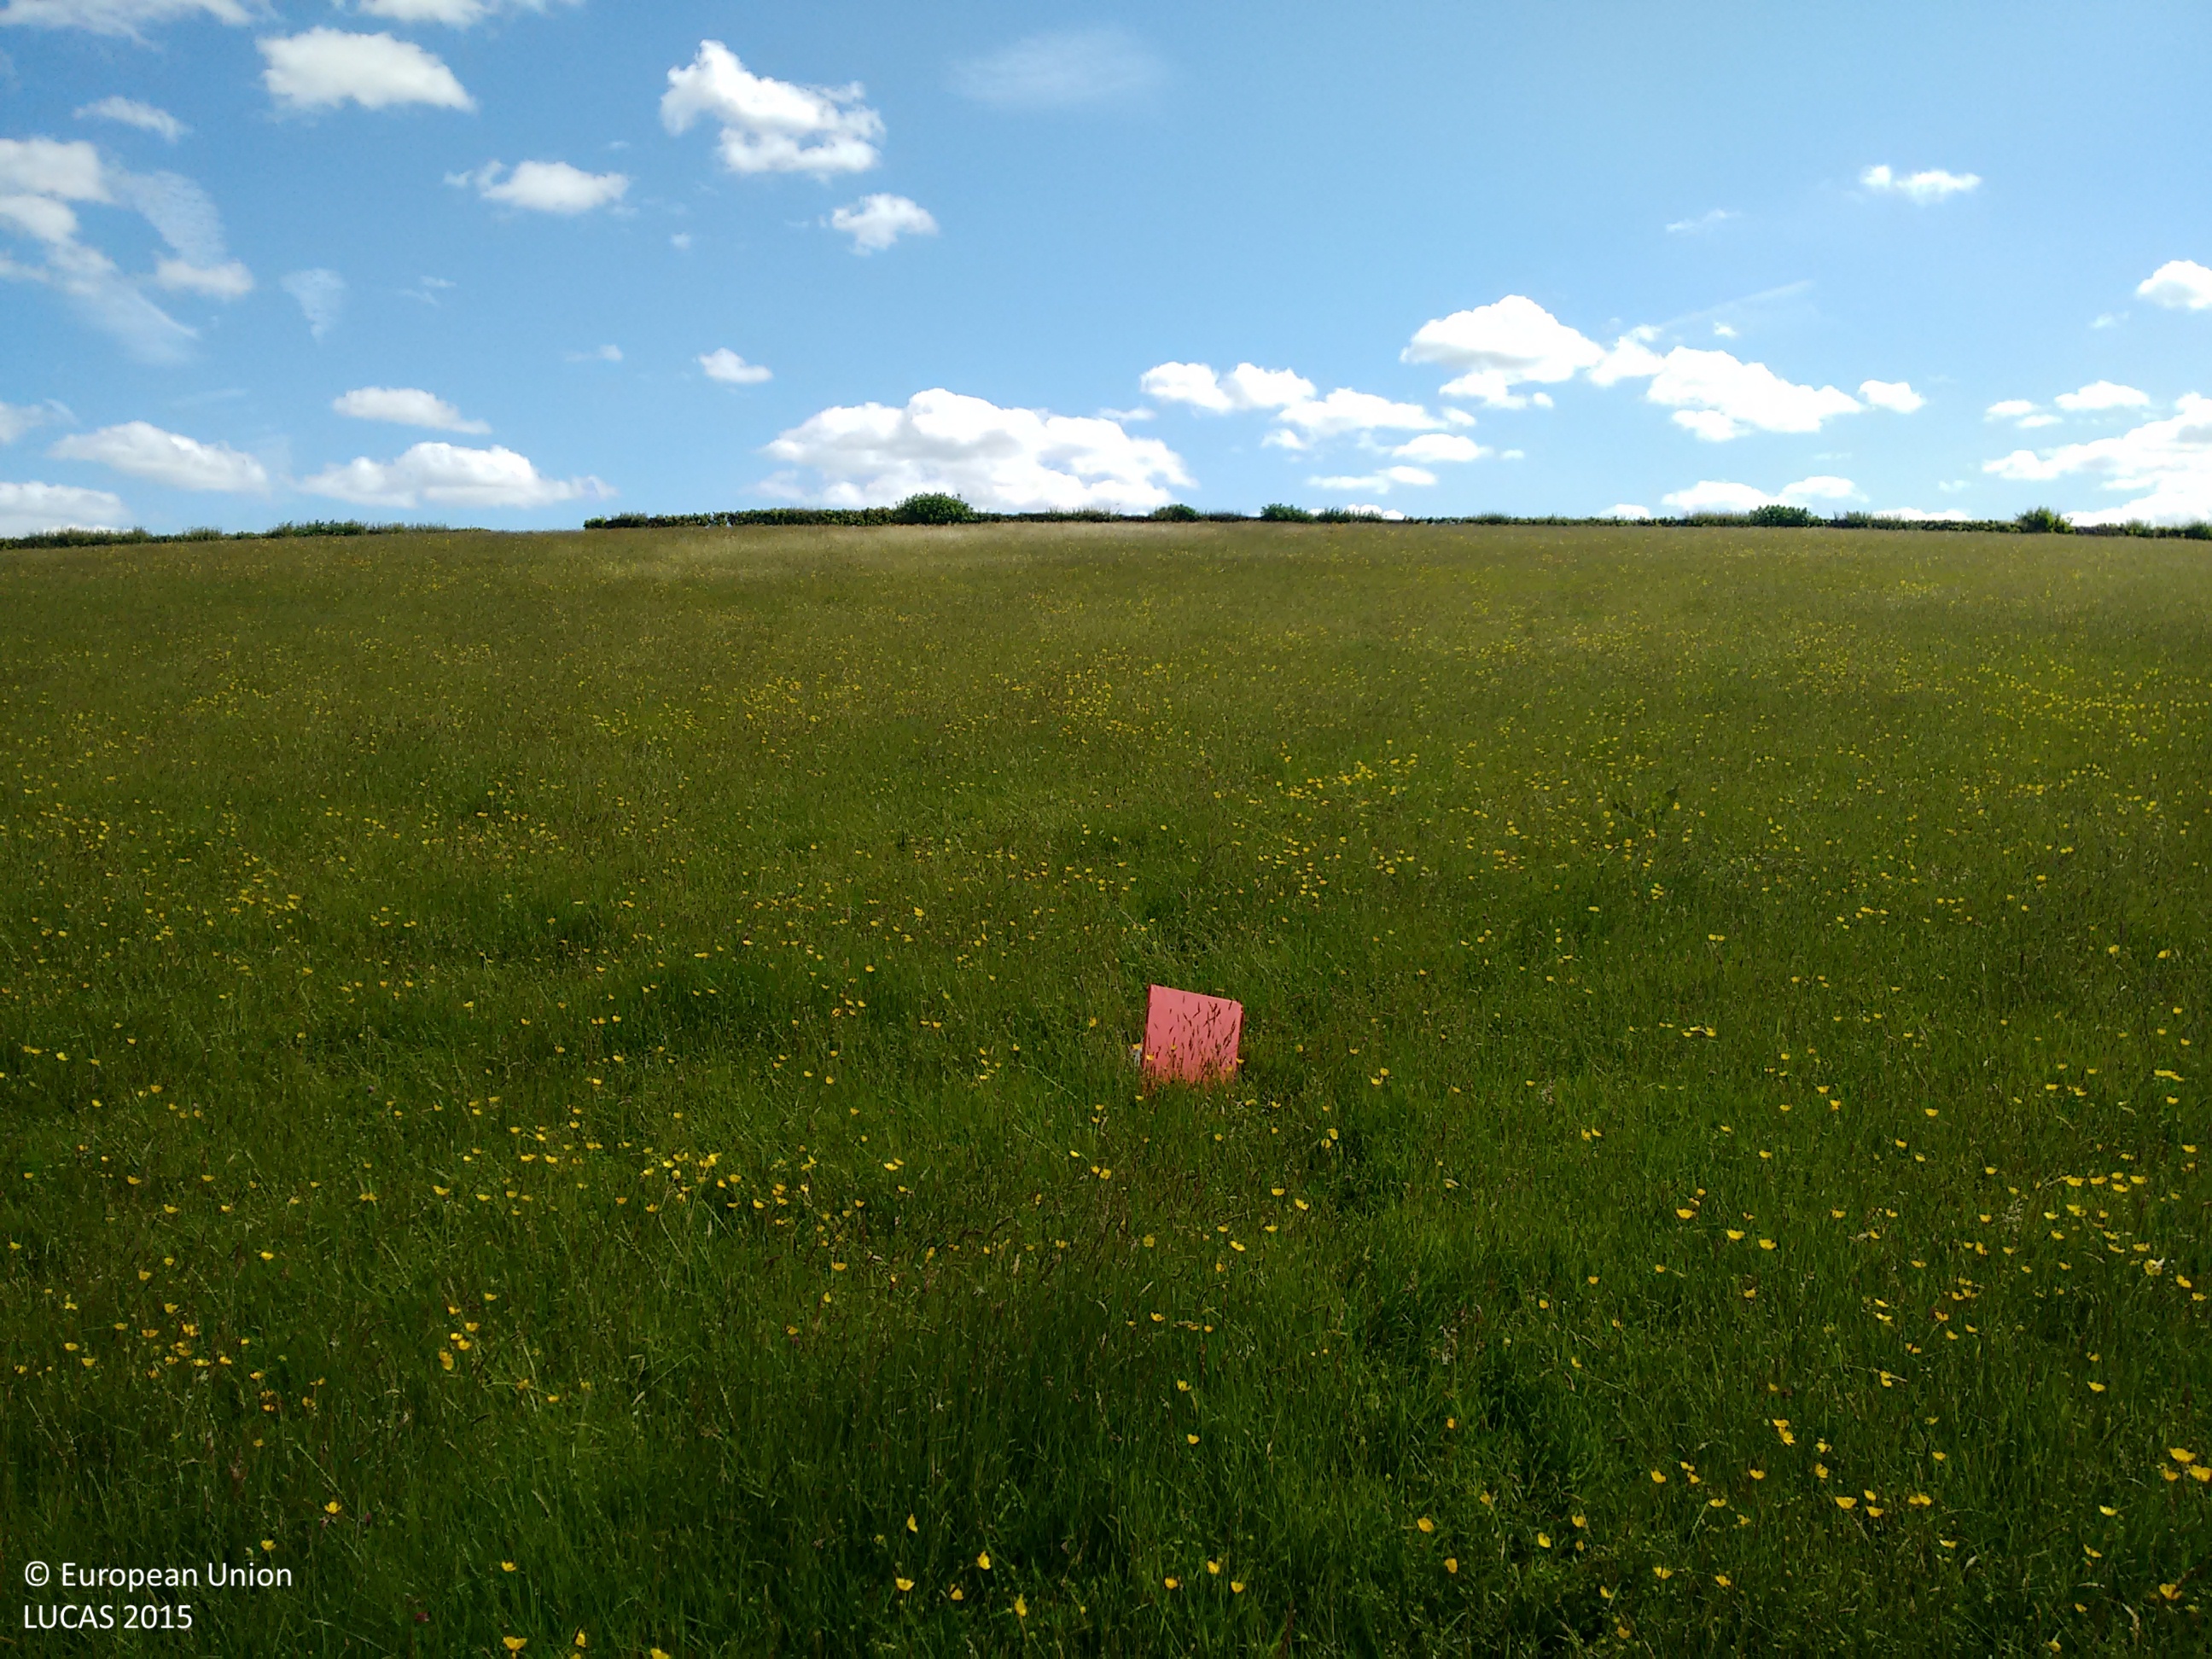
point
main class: Grassland
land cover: Grassland without tree/shrub cover
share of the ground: > 75 %
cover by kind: herbaceous plants 100 %
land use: Agriculture (excluding fallow land and kitchen gardens)
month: June
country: GB
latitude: 50.9733
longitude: 0.6166
